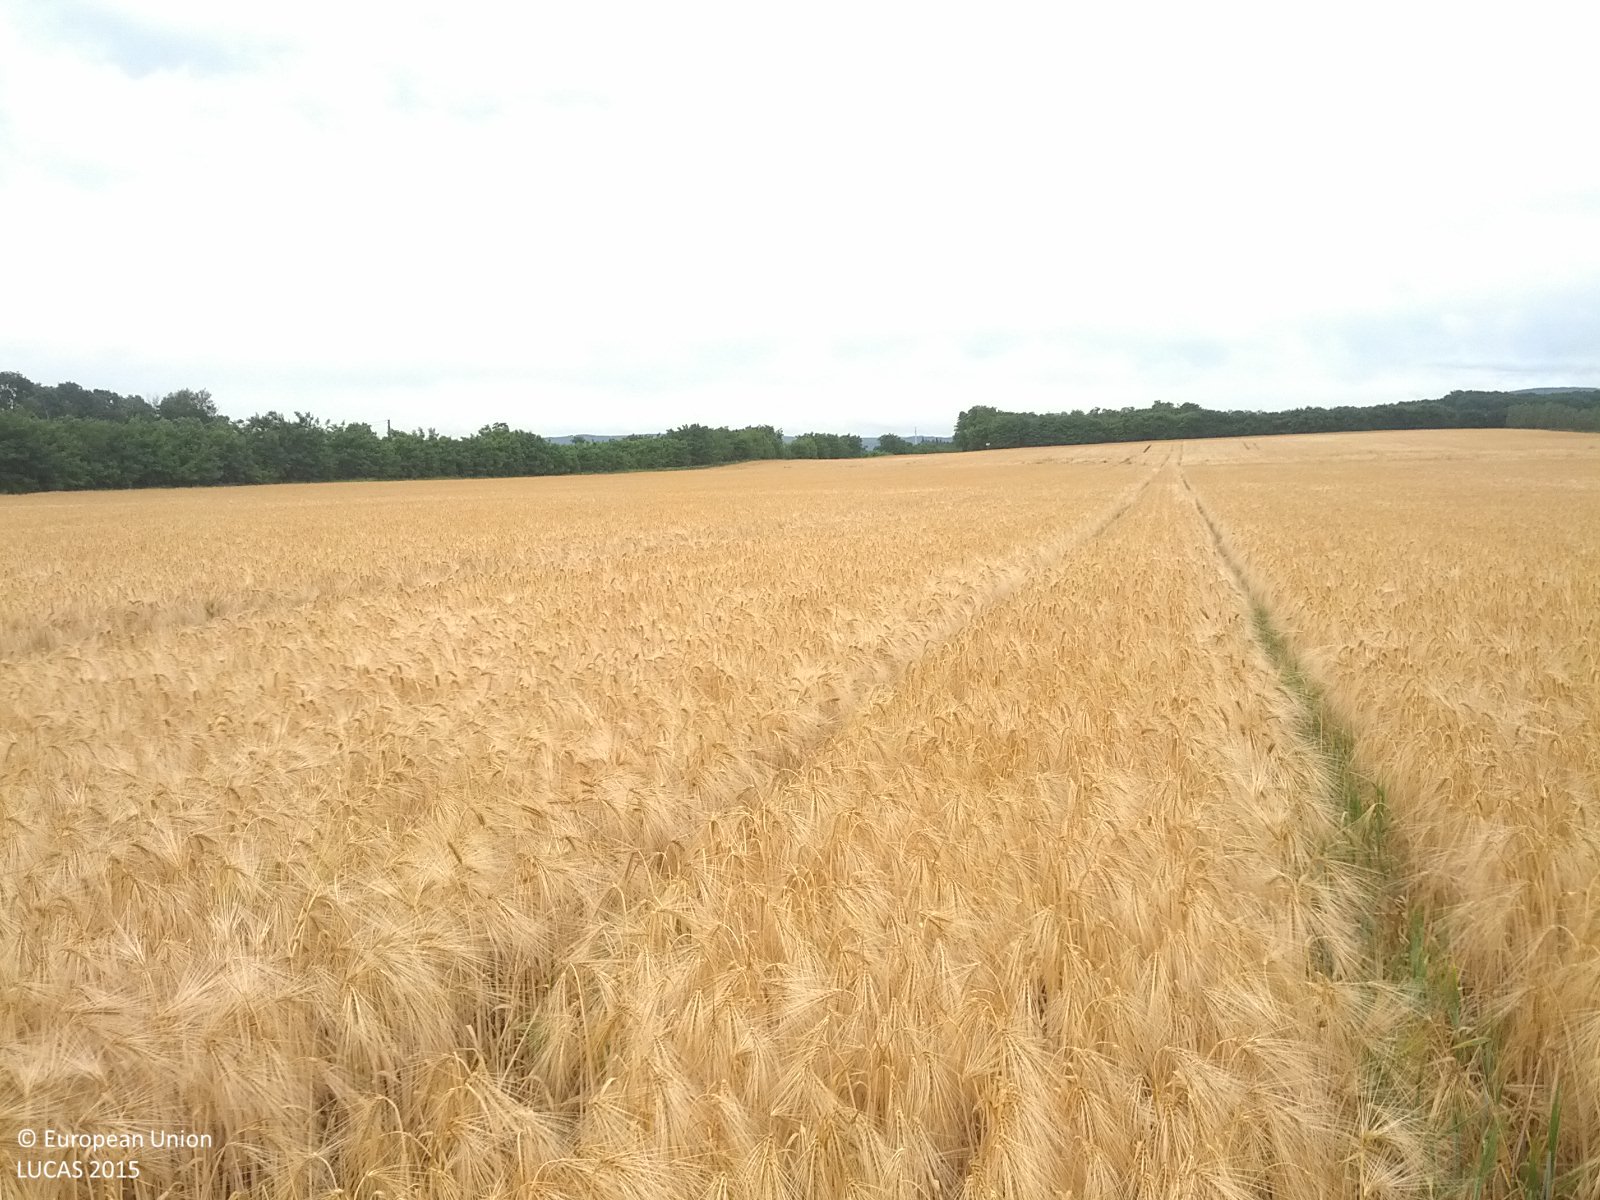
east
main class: Cropland
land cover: Barley
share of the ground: > 75 %
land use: Agriculture (excluding fallow land and kitchen gardens)
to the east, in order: Barley; Grass margins; Abandoned hedges; Ditches and canals; Shrubland without tree cover; Electric lines; Grass margins; Railways; Grass margins; Shrubland without tree cover; Common wheat
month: June
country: AT
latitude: 48.2607
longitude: 16.8906
